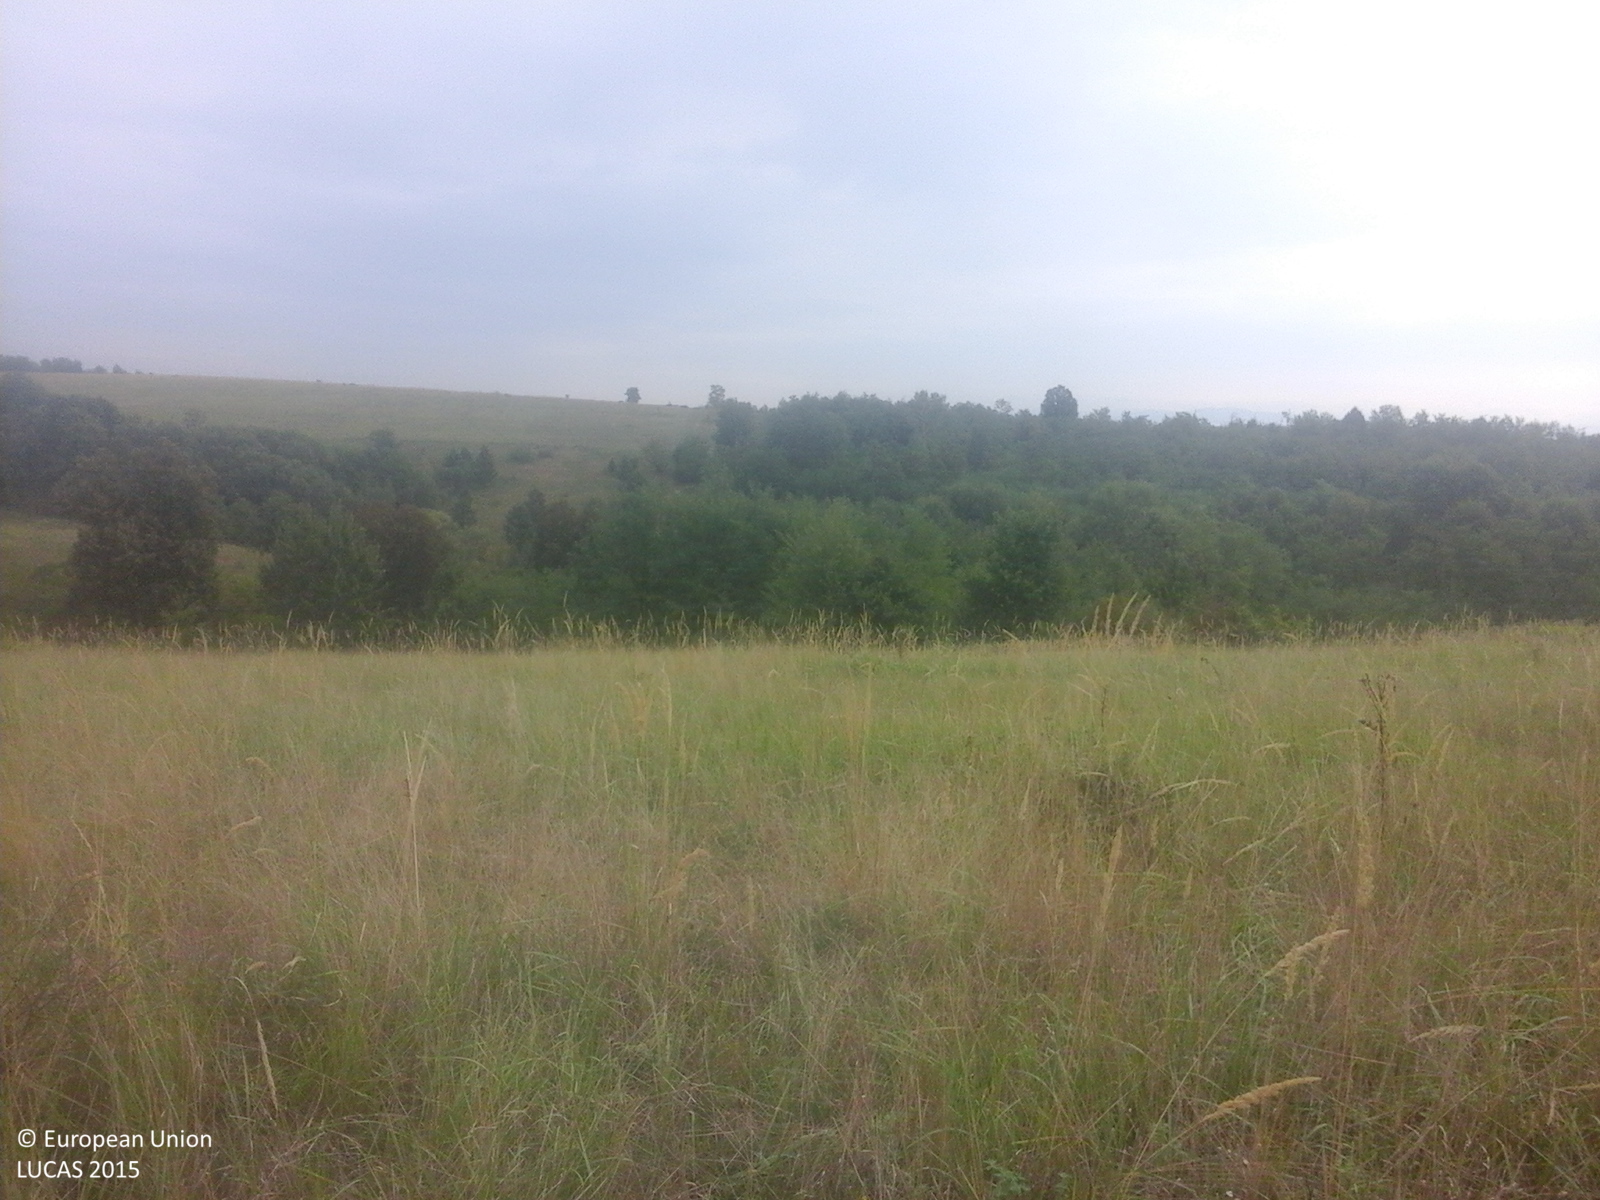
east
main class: Grassland
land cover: Grassland without tree/shrub cover
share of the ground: > 75 %
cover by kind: herbaceous plants 100 %
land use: Agriculture (excluding fallow land and kitchen gardens)
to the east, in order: Grassland without tree/shrub cover; Grassland with sparse tree/shrub cover; Broadleaved woodland; Grassland with sparse tree/shrub cover; Broadleaved woodland; Grassland without tree/shrub cover; Tracks; Grassland with sparse tree/shrub cover; Broadleaved woodland
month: September
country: RO
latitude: 45.8811
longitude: 22.0894
